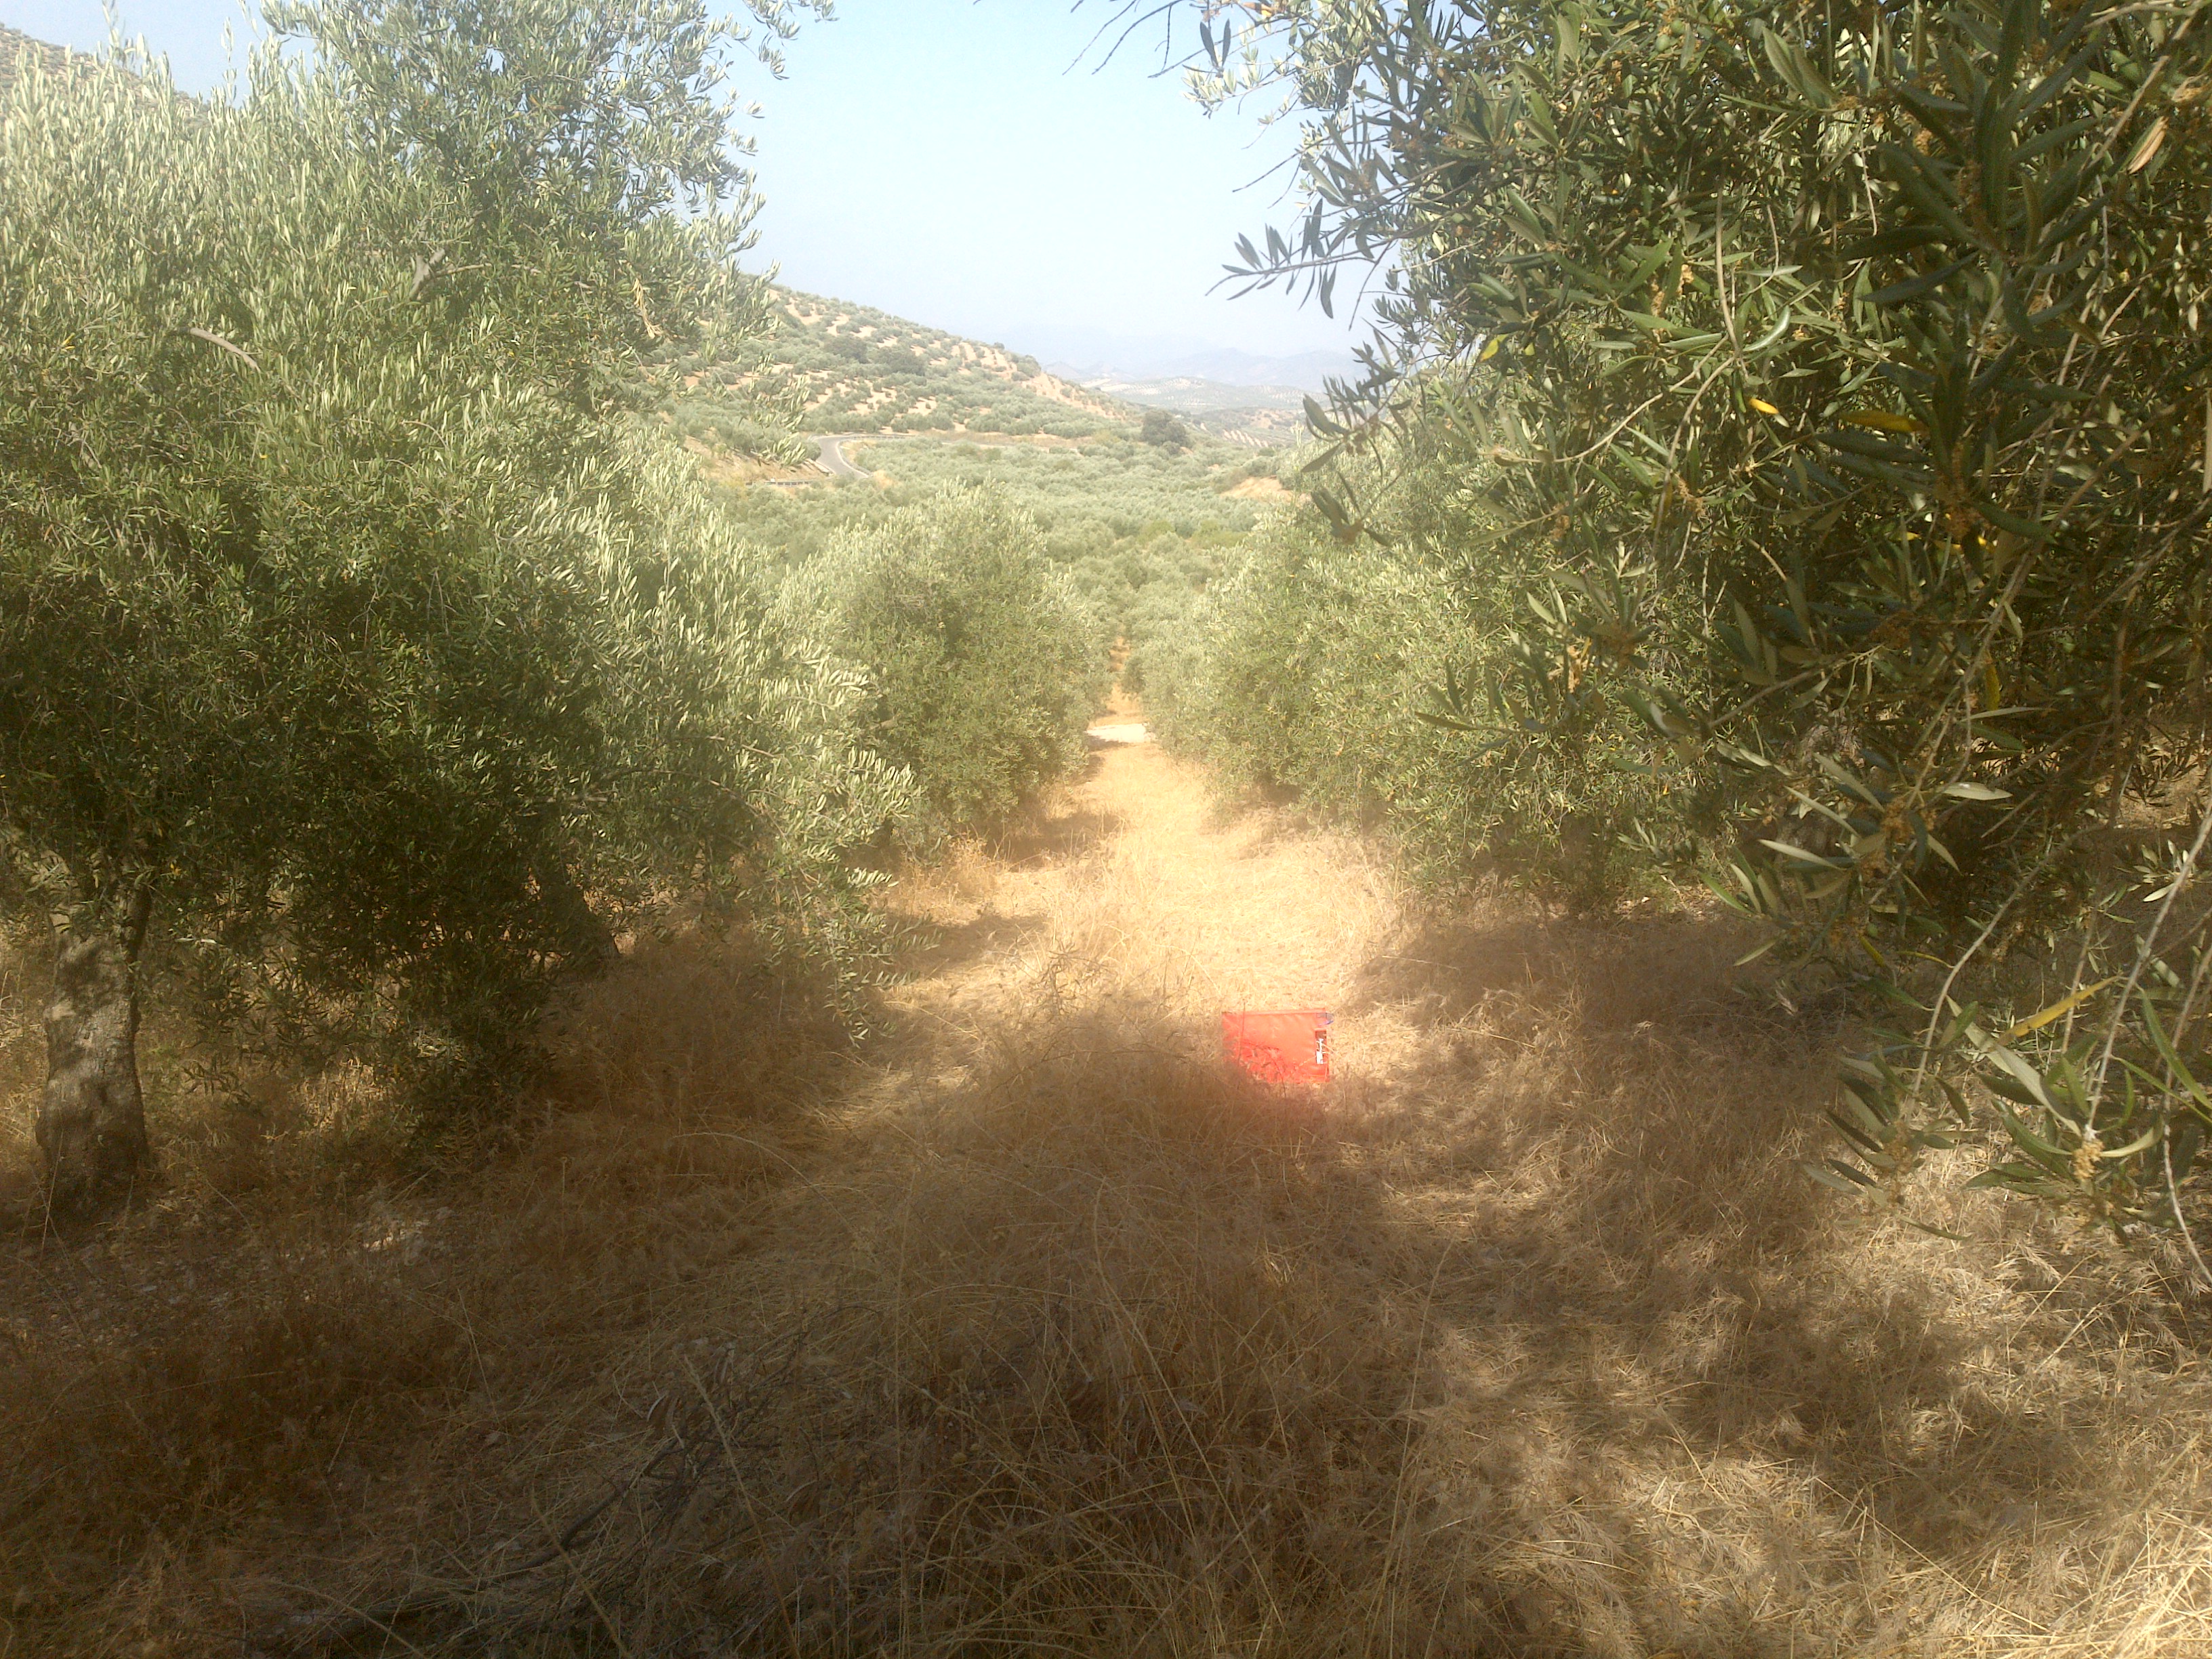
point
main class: Cropland
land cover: Olive groves
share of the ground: 50 - 75 %
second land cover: Spontaneously vegetated surfaces
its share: 25 - 50 %
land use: Agriculture (excluding fallow land and kitchen gardens)
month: June
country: ES
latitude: 37.5179
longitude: -4.2233
